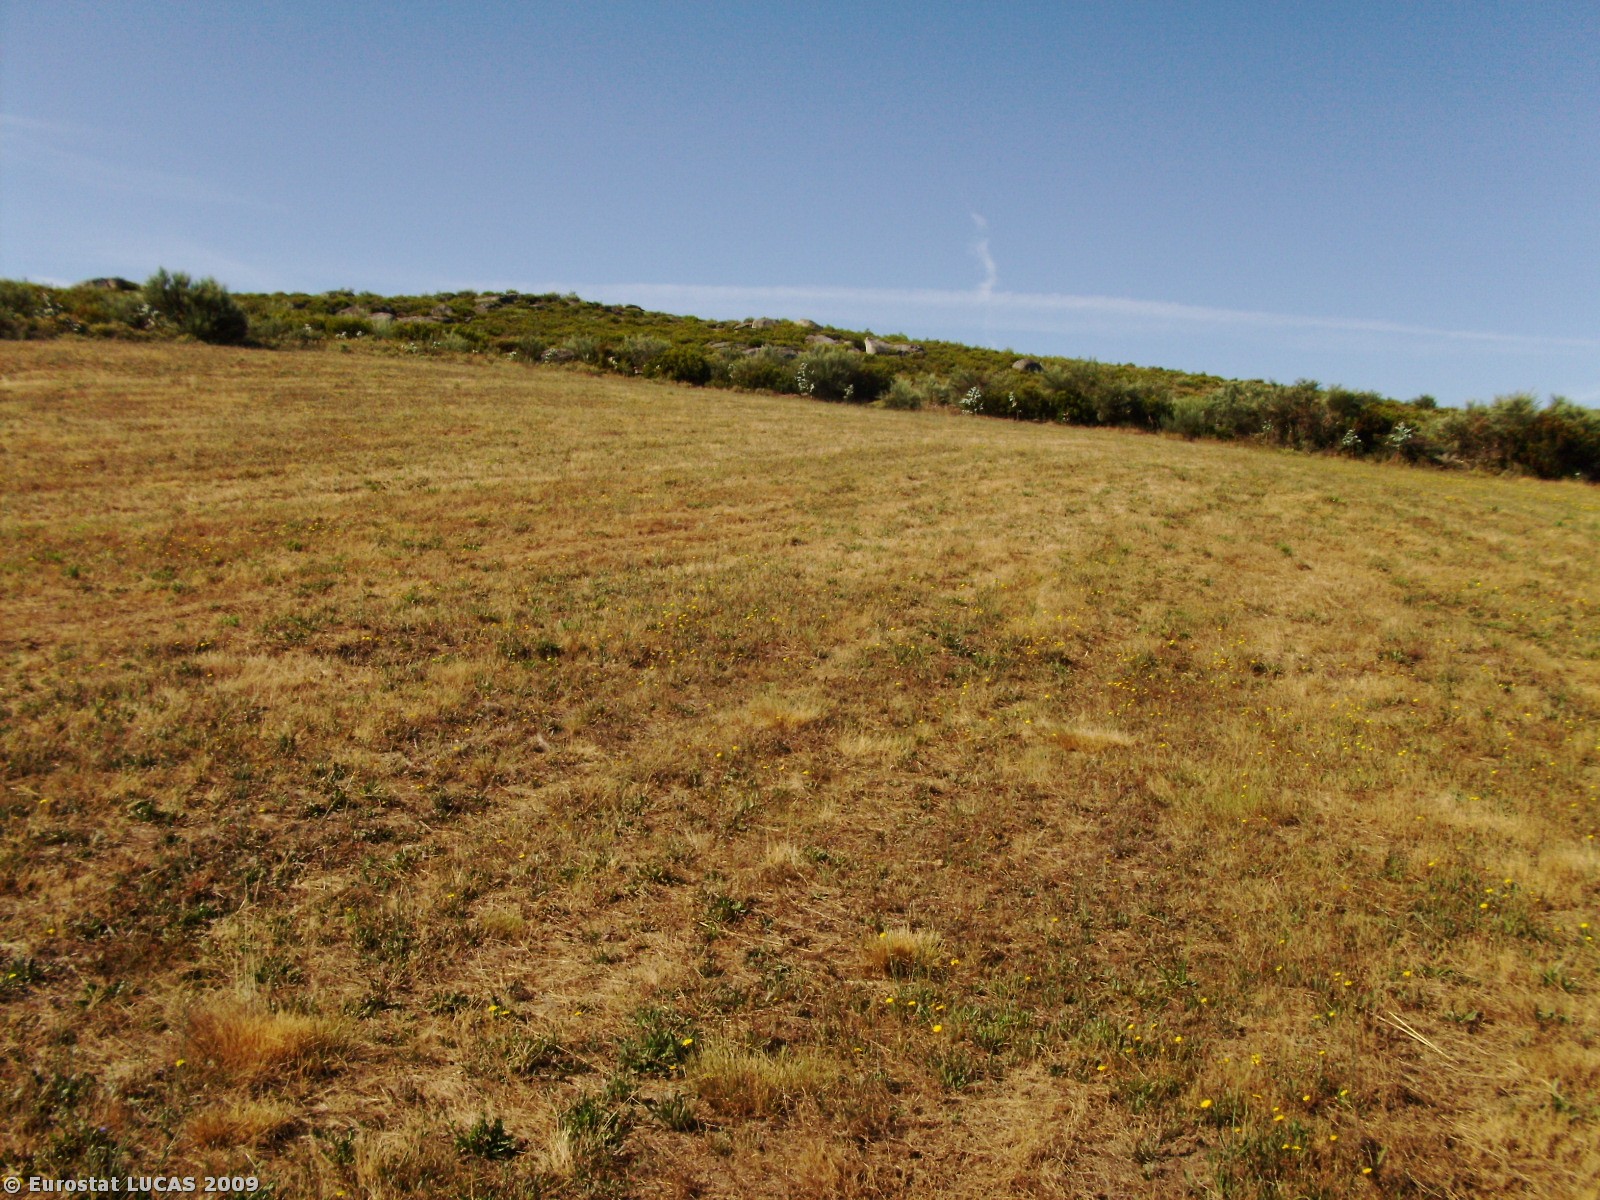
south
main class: Grassland
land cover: Spontaneously vegetated surfaces
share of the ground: > 75 %
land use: Fallow land
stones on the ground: < 10 %
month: July
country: PT
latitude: 40.9657
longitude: -7.7222
